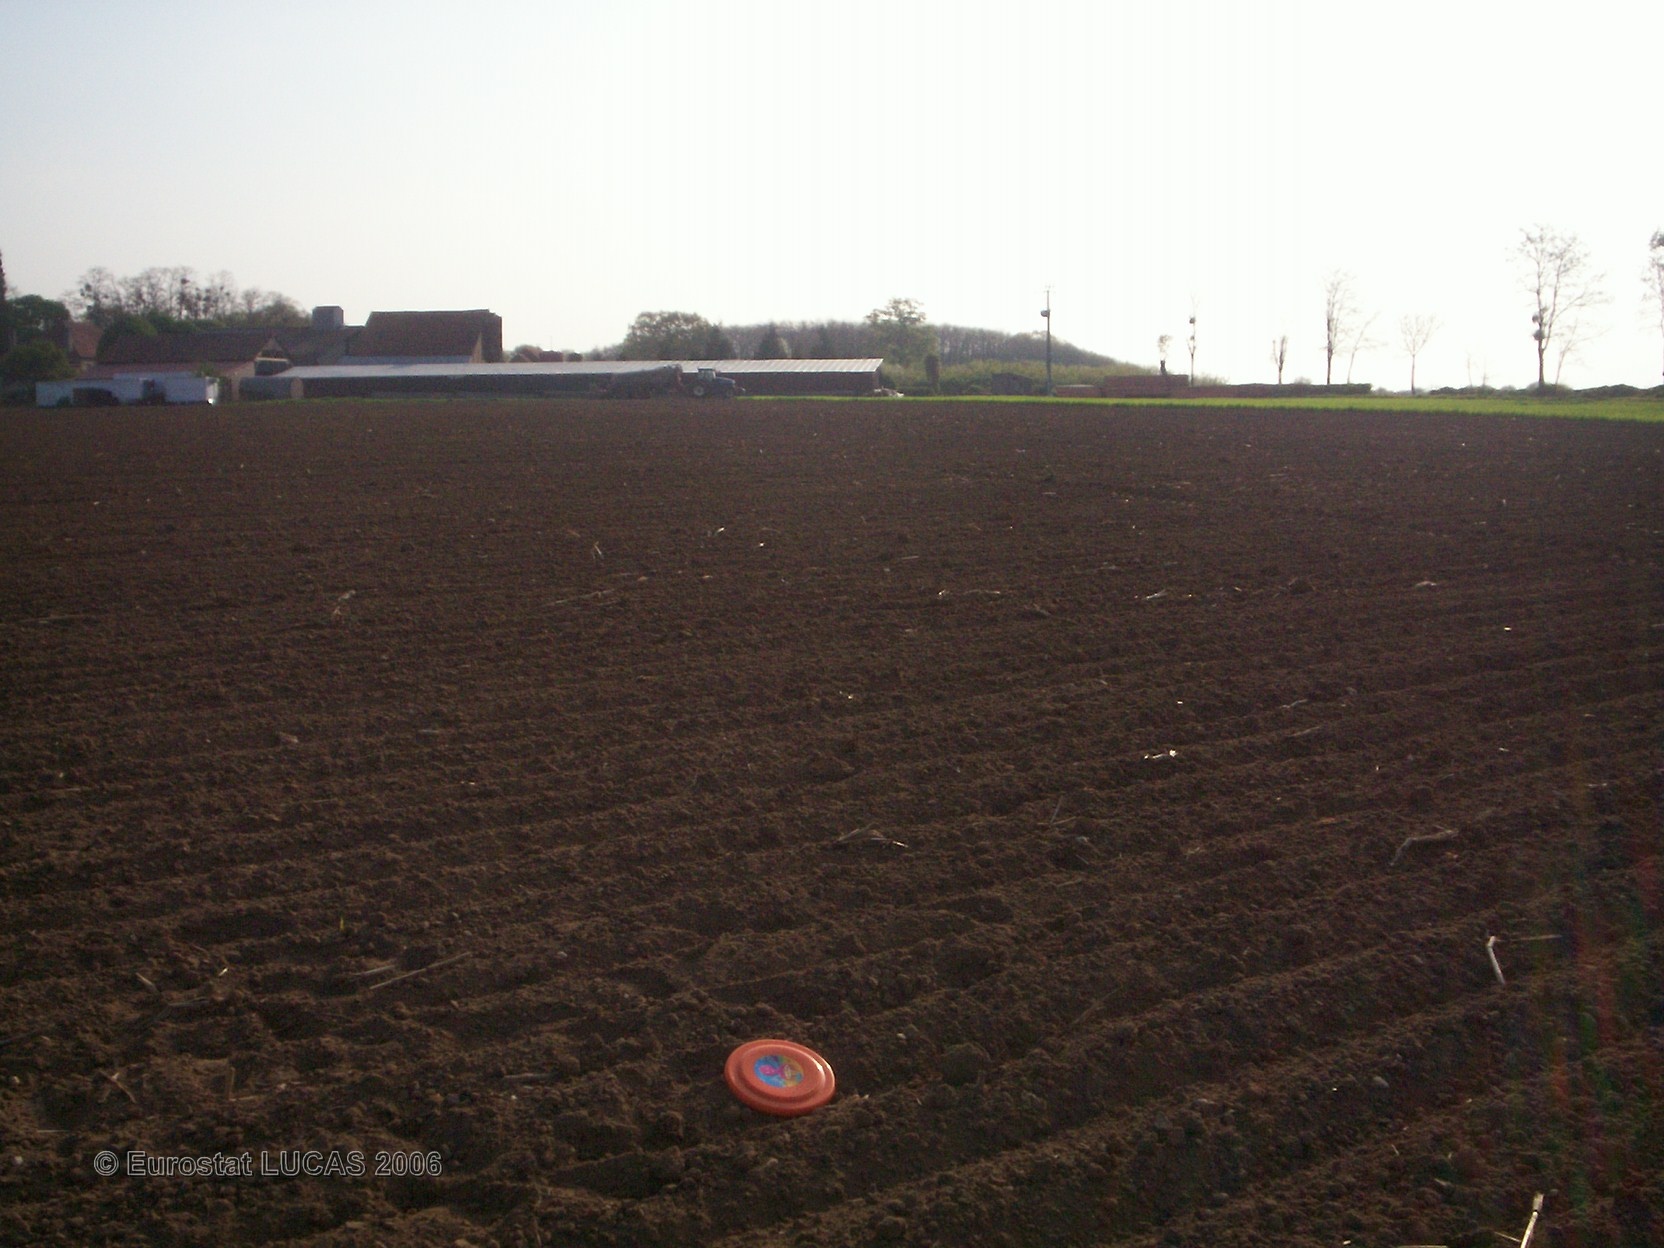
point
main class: Cropland
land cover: Maize
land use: Agriculture (excluding fallow land and kitchen gardens)
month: May
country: FR
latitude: 47.2085
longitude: 3.0375
